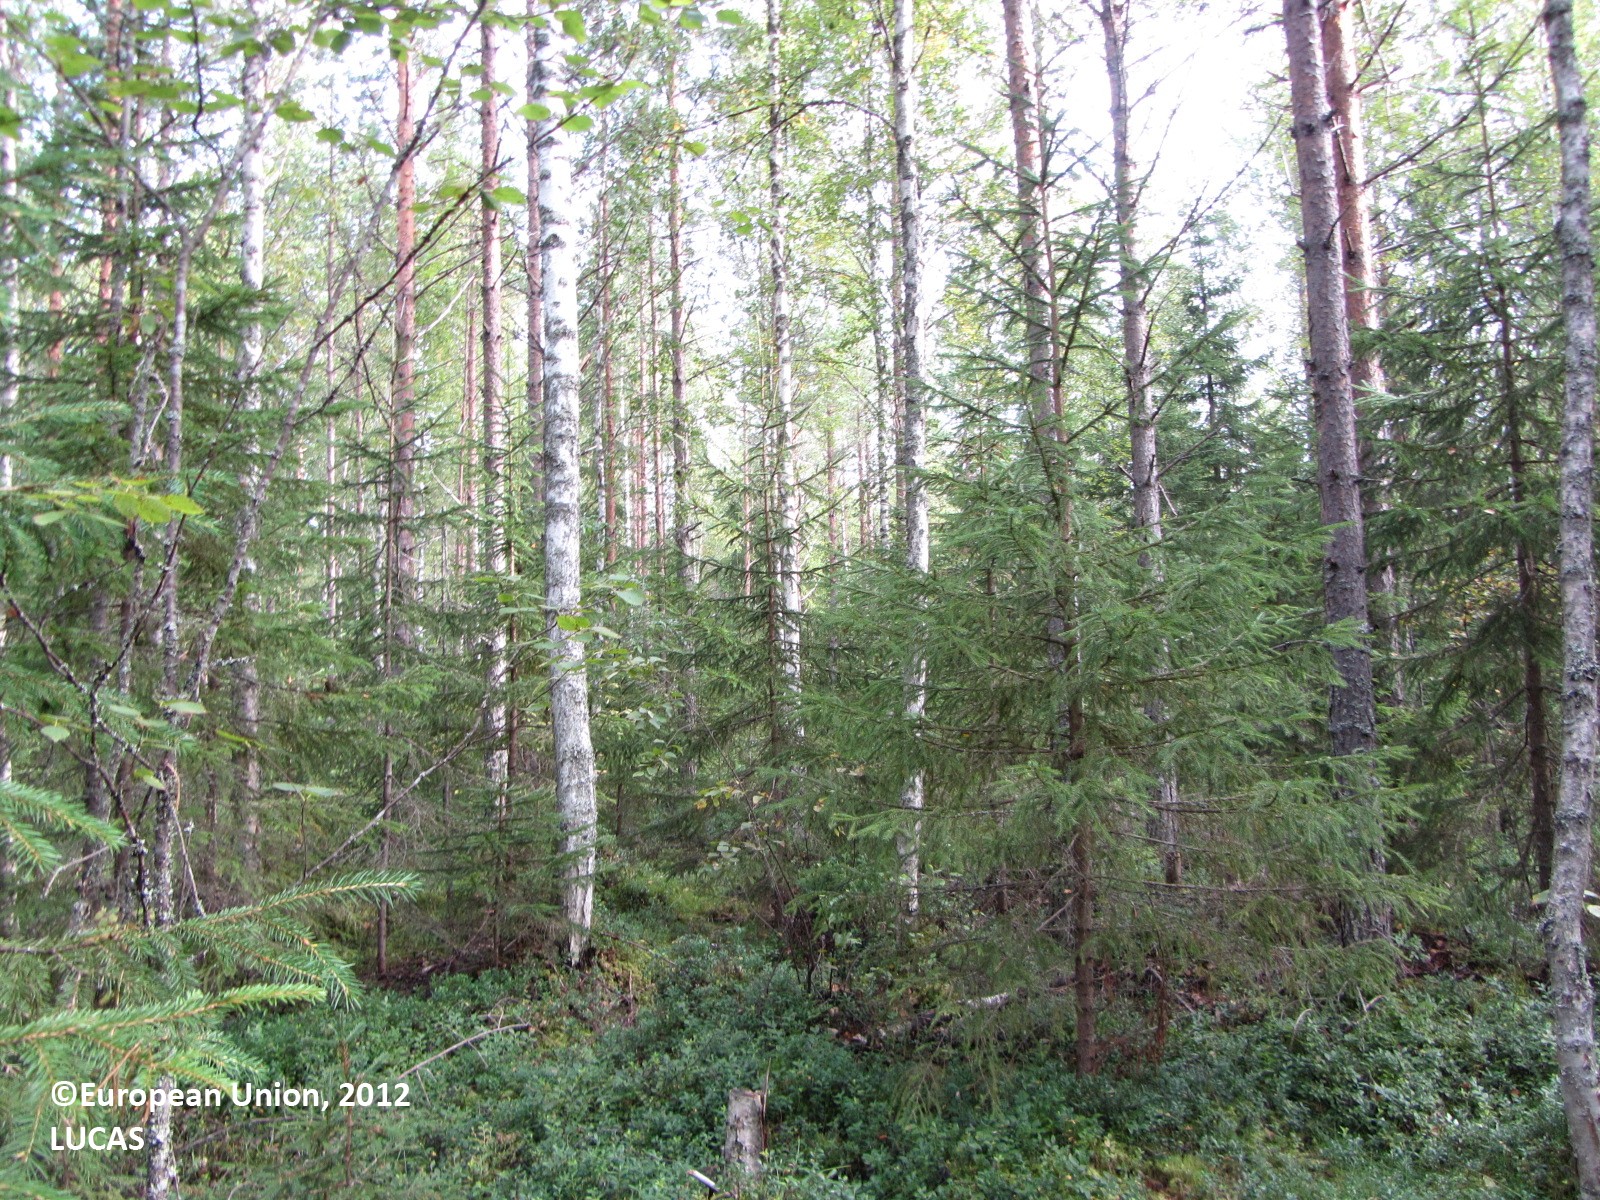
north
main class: Woodland
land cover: Pine dominated mixed woodland
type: boreal forest
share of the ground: > 75 %
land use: Forestry
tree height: > 5 m
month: August
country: FI
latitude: 63.0069
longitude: 25.0861
